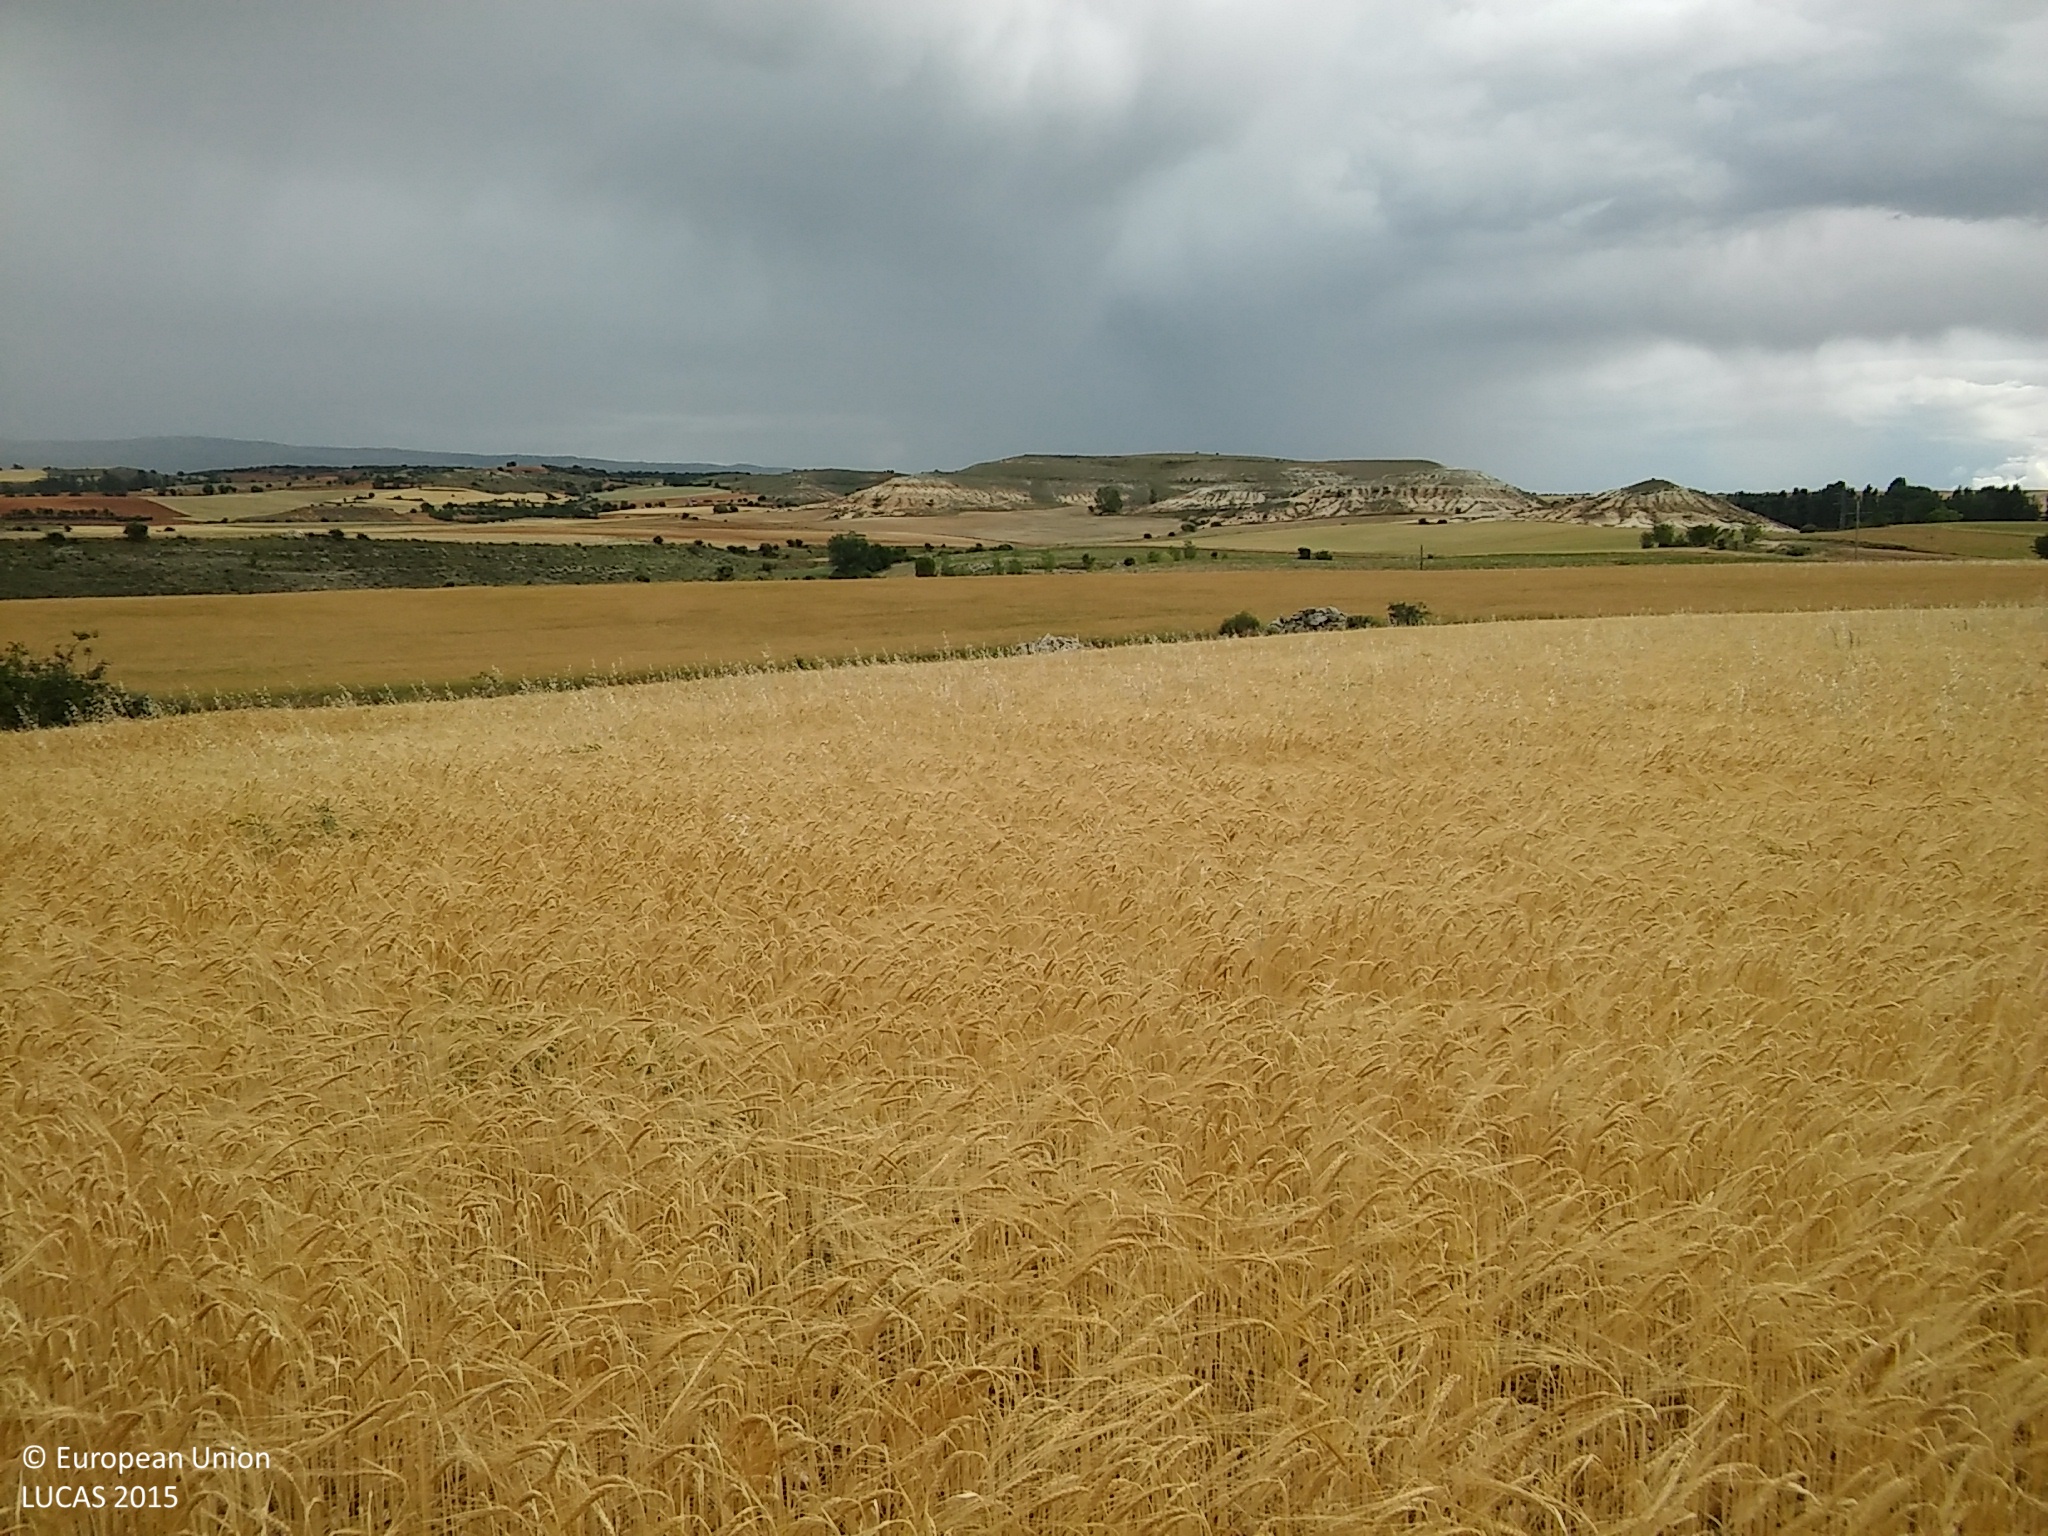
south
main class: Cropland
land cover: Barley
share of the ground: > 75 %
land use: Agriculture (excluding fallow land and kitchen gardens)
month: June
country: ES
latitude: 41.5427
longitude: -3.7781
